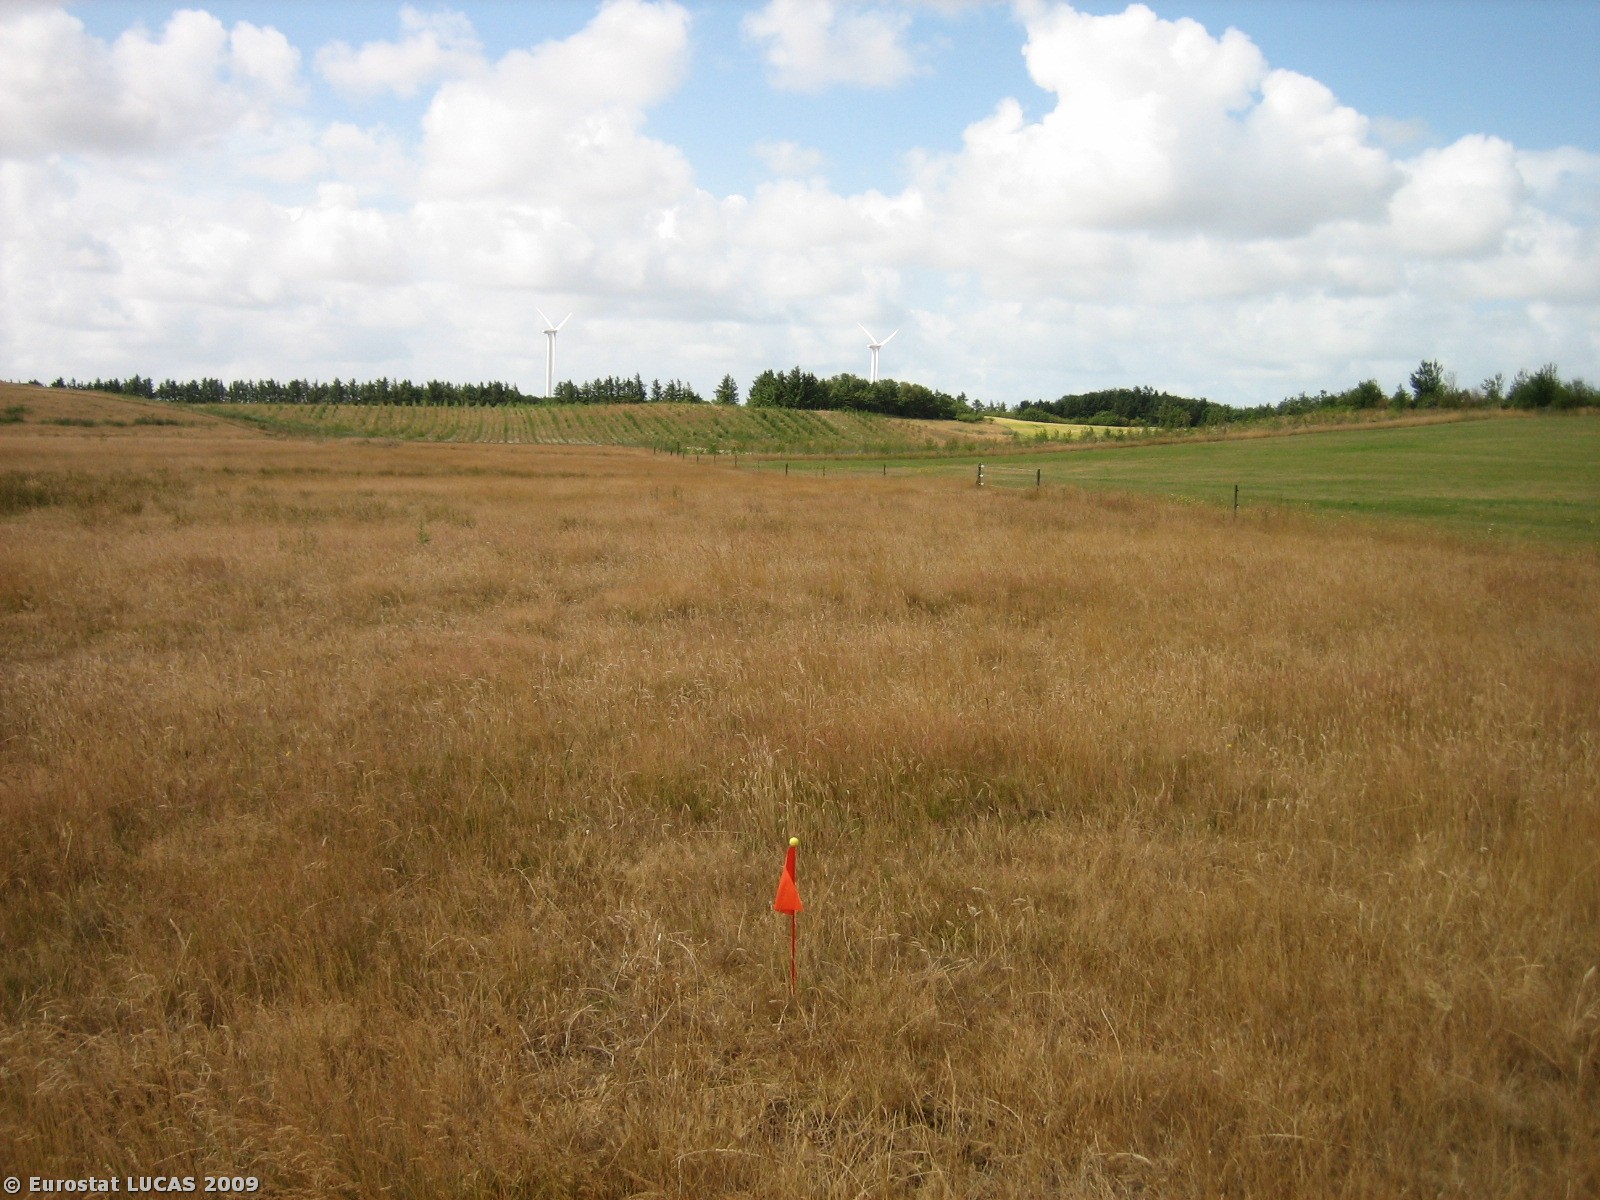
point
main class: Grassland
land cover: Grassland without tree/shrub cover
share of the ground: > 75 %
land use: Agriculture (excluding fallow land and kitchen gardens)
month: July
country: DK
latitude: 55.5661
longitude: 8.3681
